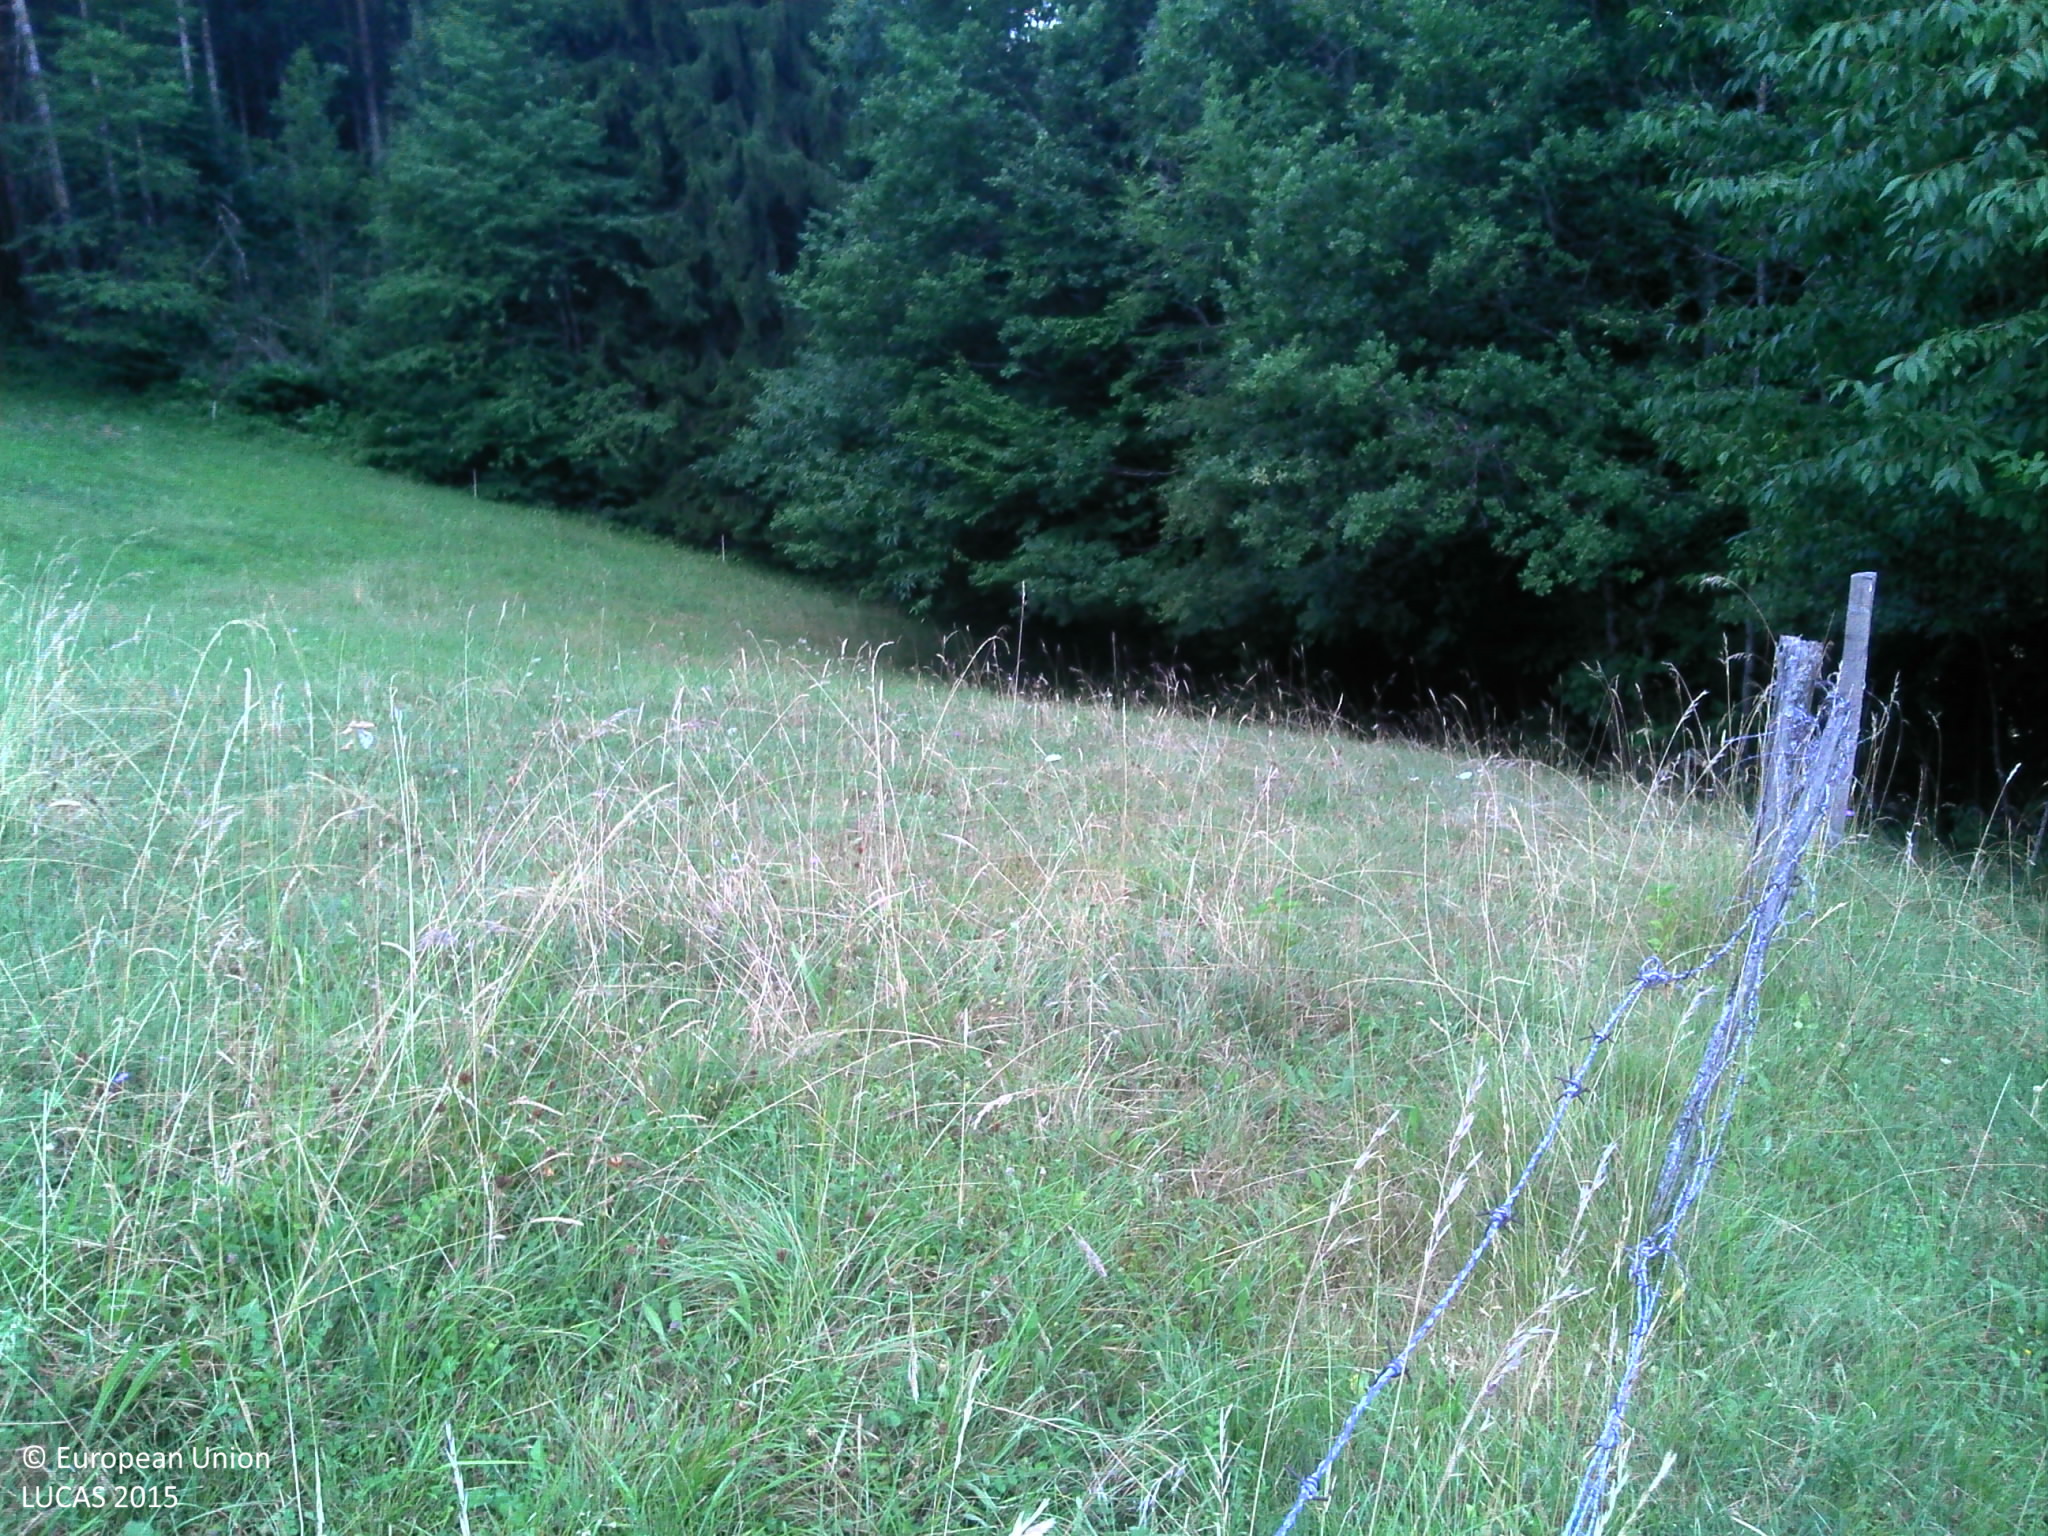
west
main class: Grassland
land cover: Grassland without tree/shrub cover
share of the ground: > 75 %
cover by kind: herbaceous plants 100 %
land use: Agriculture (excluding fallow land and kitchen gardens)
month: July
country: FR
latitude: 45.9231
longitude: 6.2000
